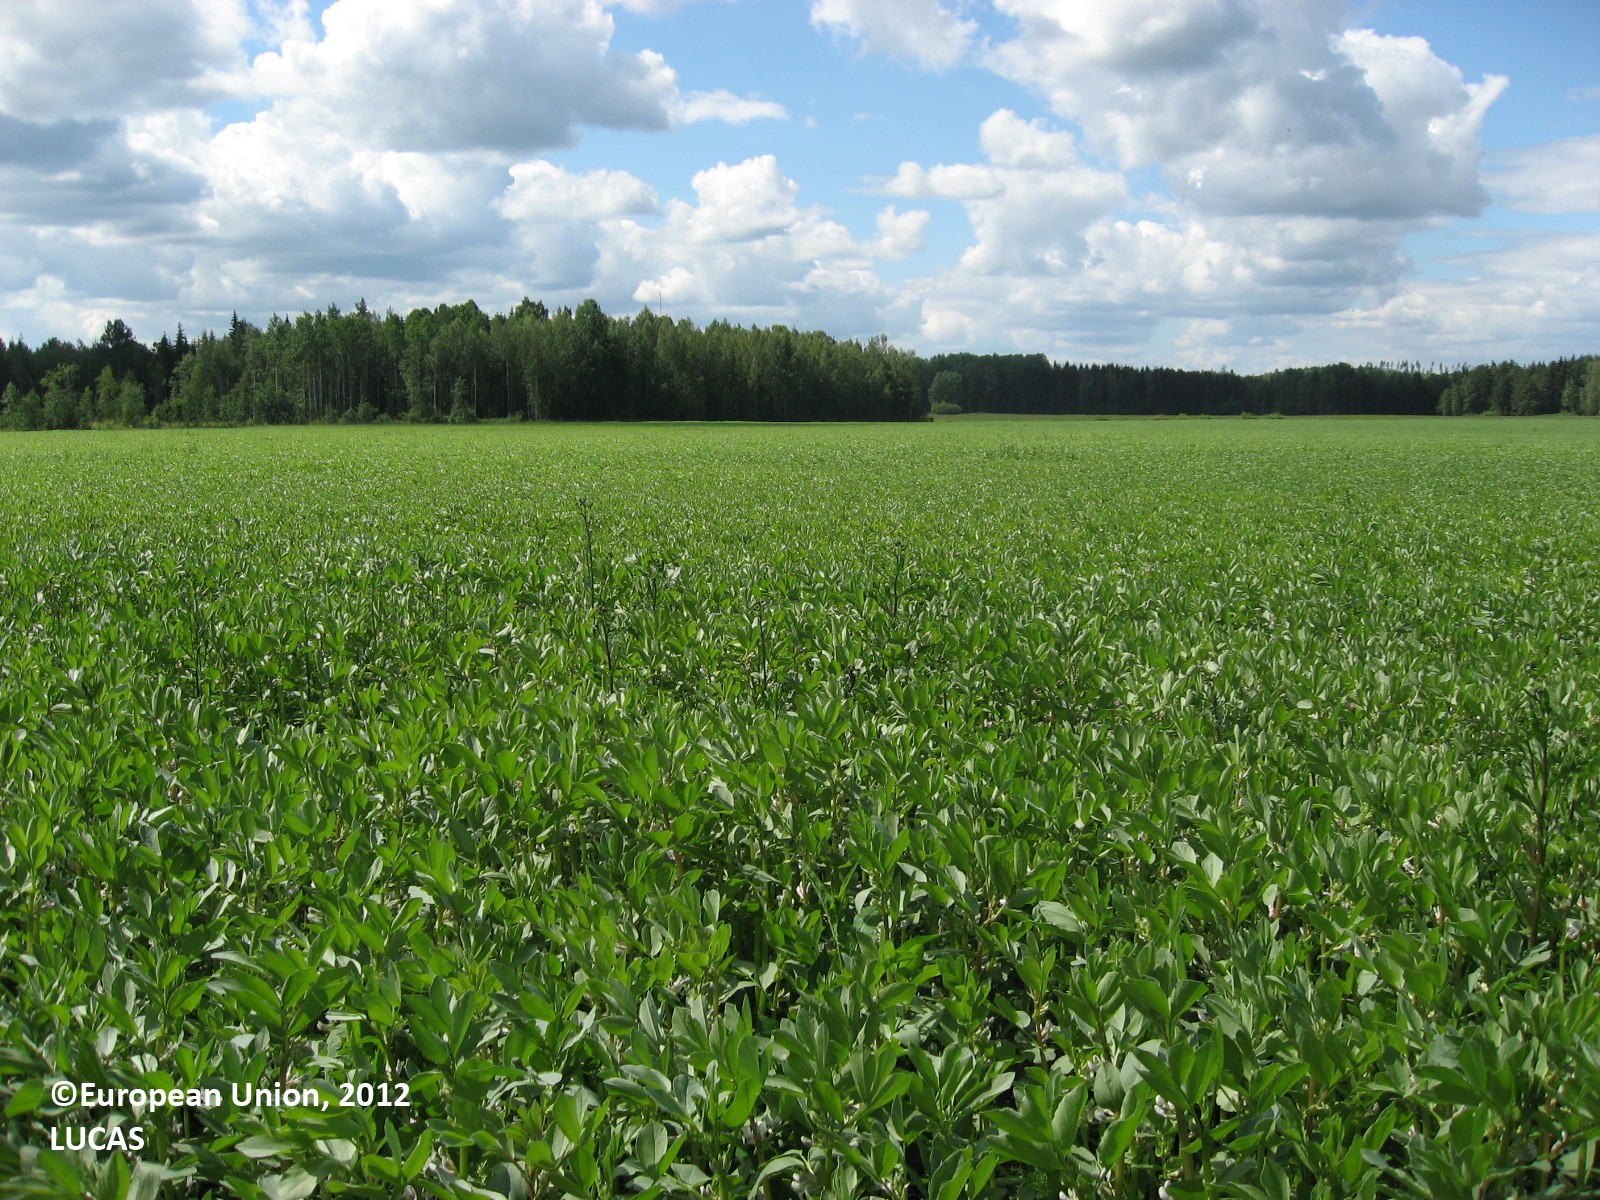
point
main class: Cropland
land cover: Dry pulses
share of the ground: > 75 %
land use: Agriculture (excluding fallow land and kitchen gardens)
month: July
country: FI
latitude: 60.7431
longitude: 26.2334
